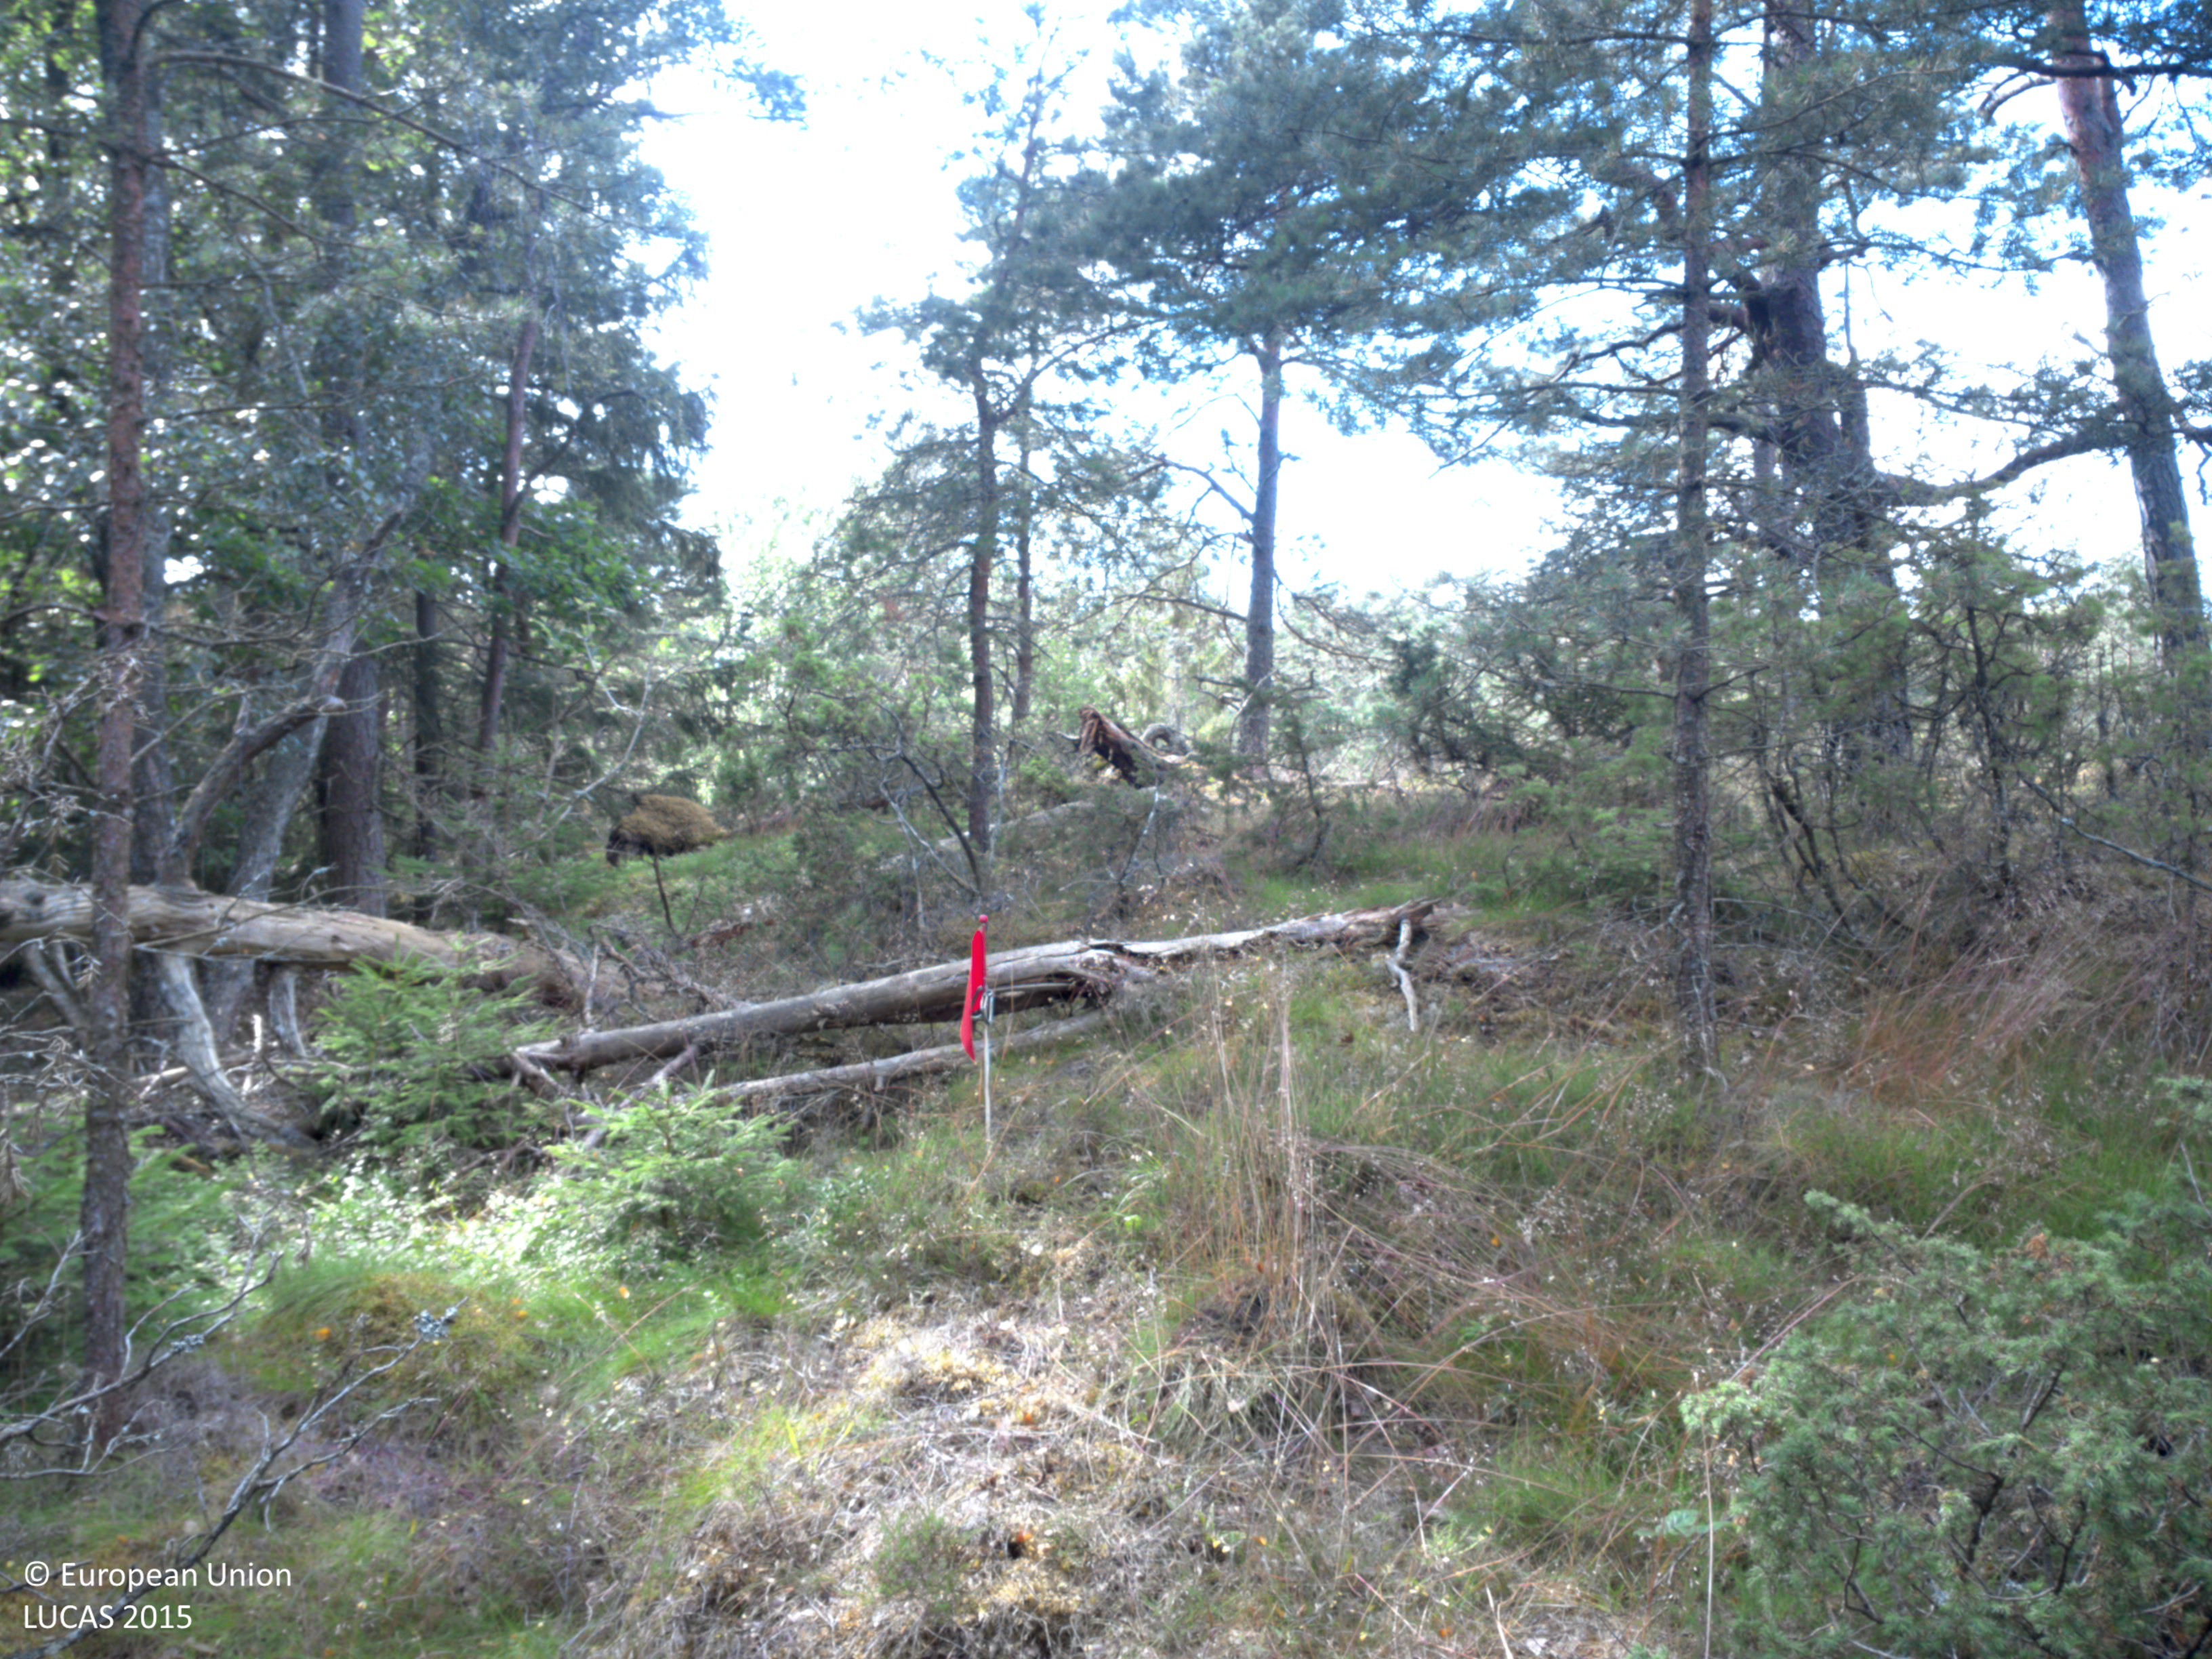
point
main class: Woodland
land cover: Pine dominated coniferous woodland
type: boreal forest
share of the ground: 50 - 75 %
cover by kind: coniferous forest trees 50 %, lichens and mosses 25 %, consolidated bare surface 15 %, herbaceous plants 10 %
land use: Forestry
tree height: > 5 m
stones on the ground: < 10 %
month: July
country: SE
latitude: 58.2090
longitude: 11.6815
